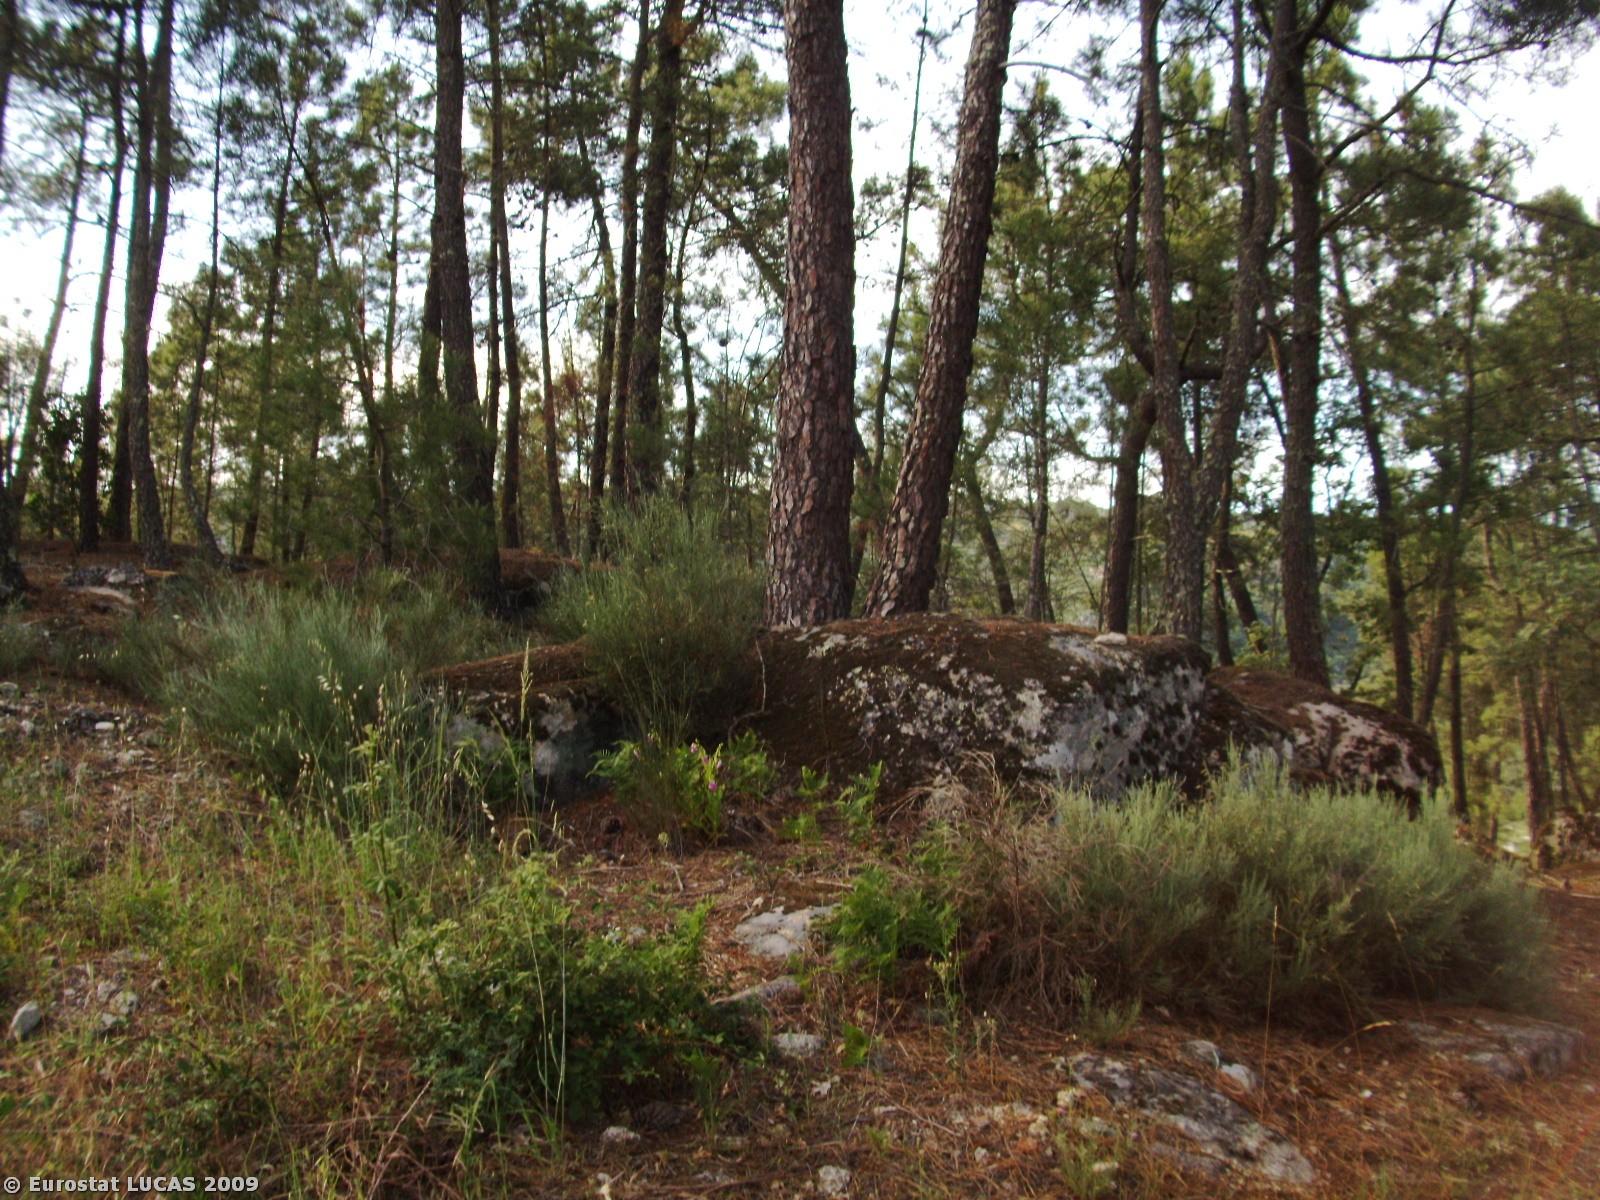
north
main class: Grassland
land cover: Spontaneously vegetated surfaces
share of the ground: > 75 %
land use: Fallow land
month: May
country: PT
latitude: 40.6575
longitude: -7.4879
